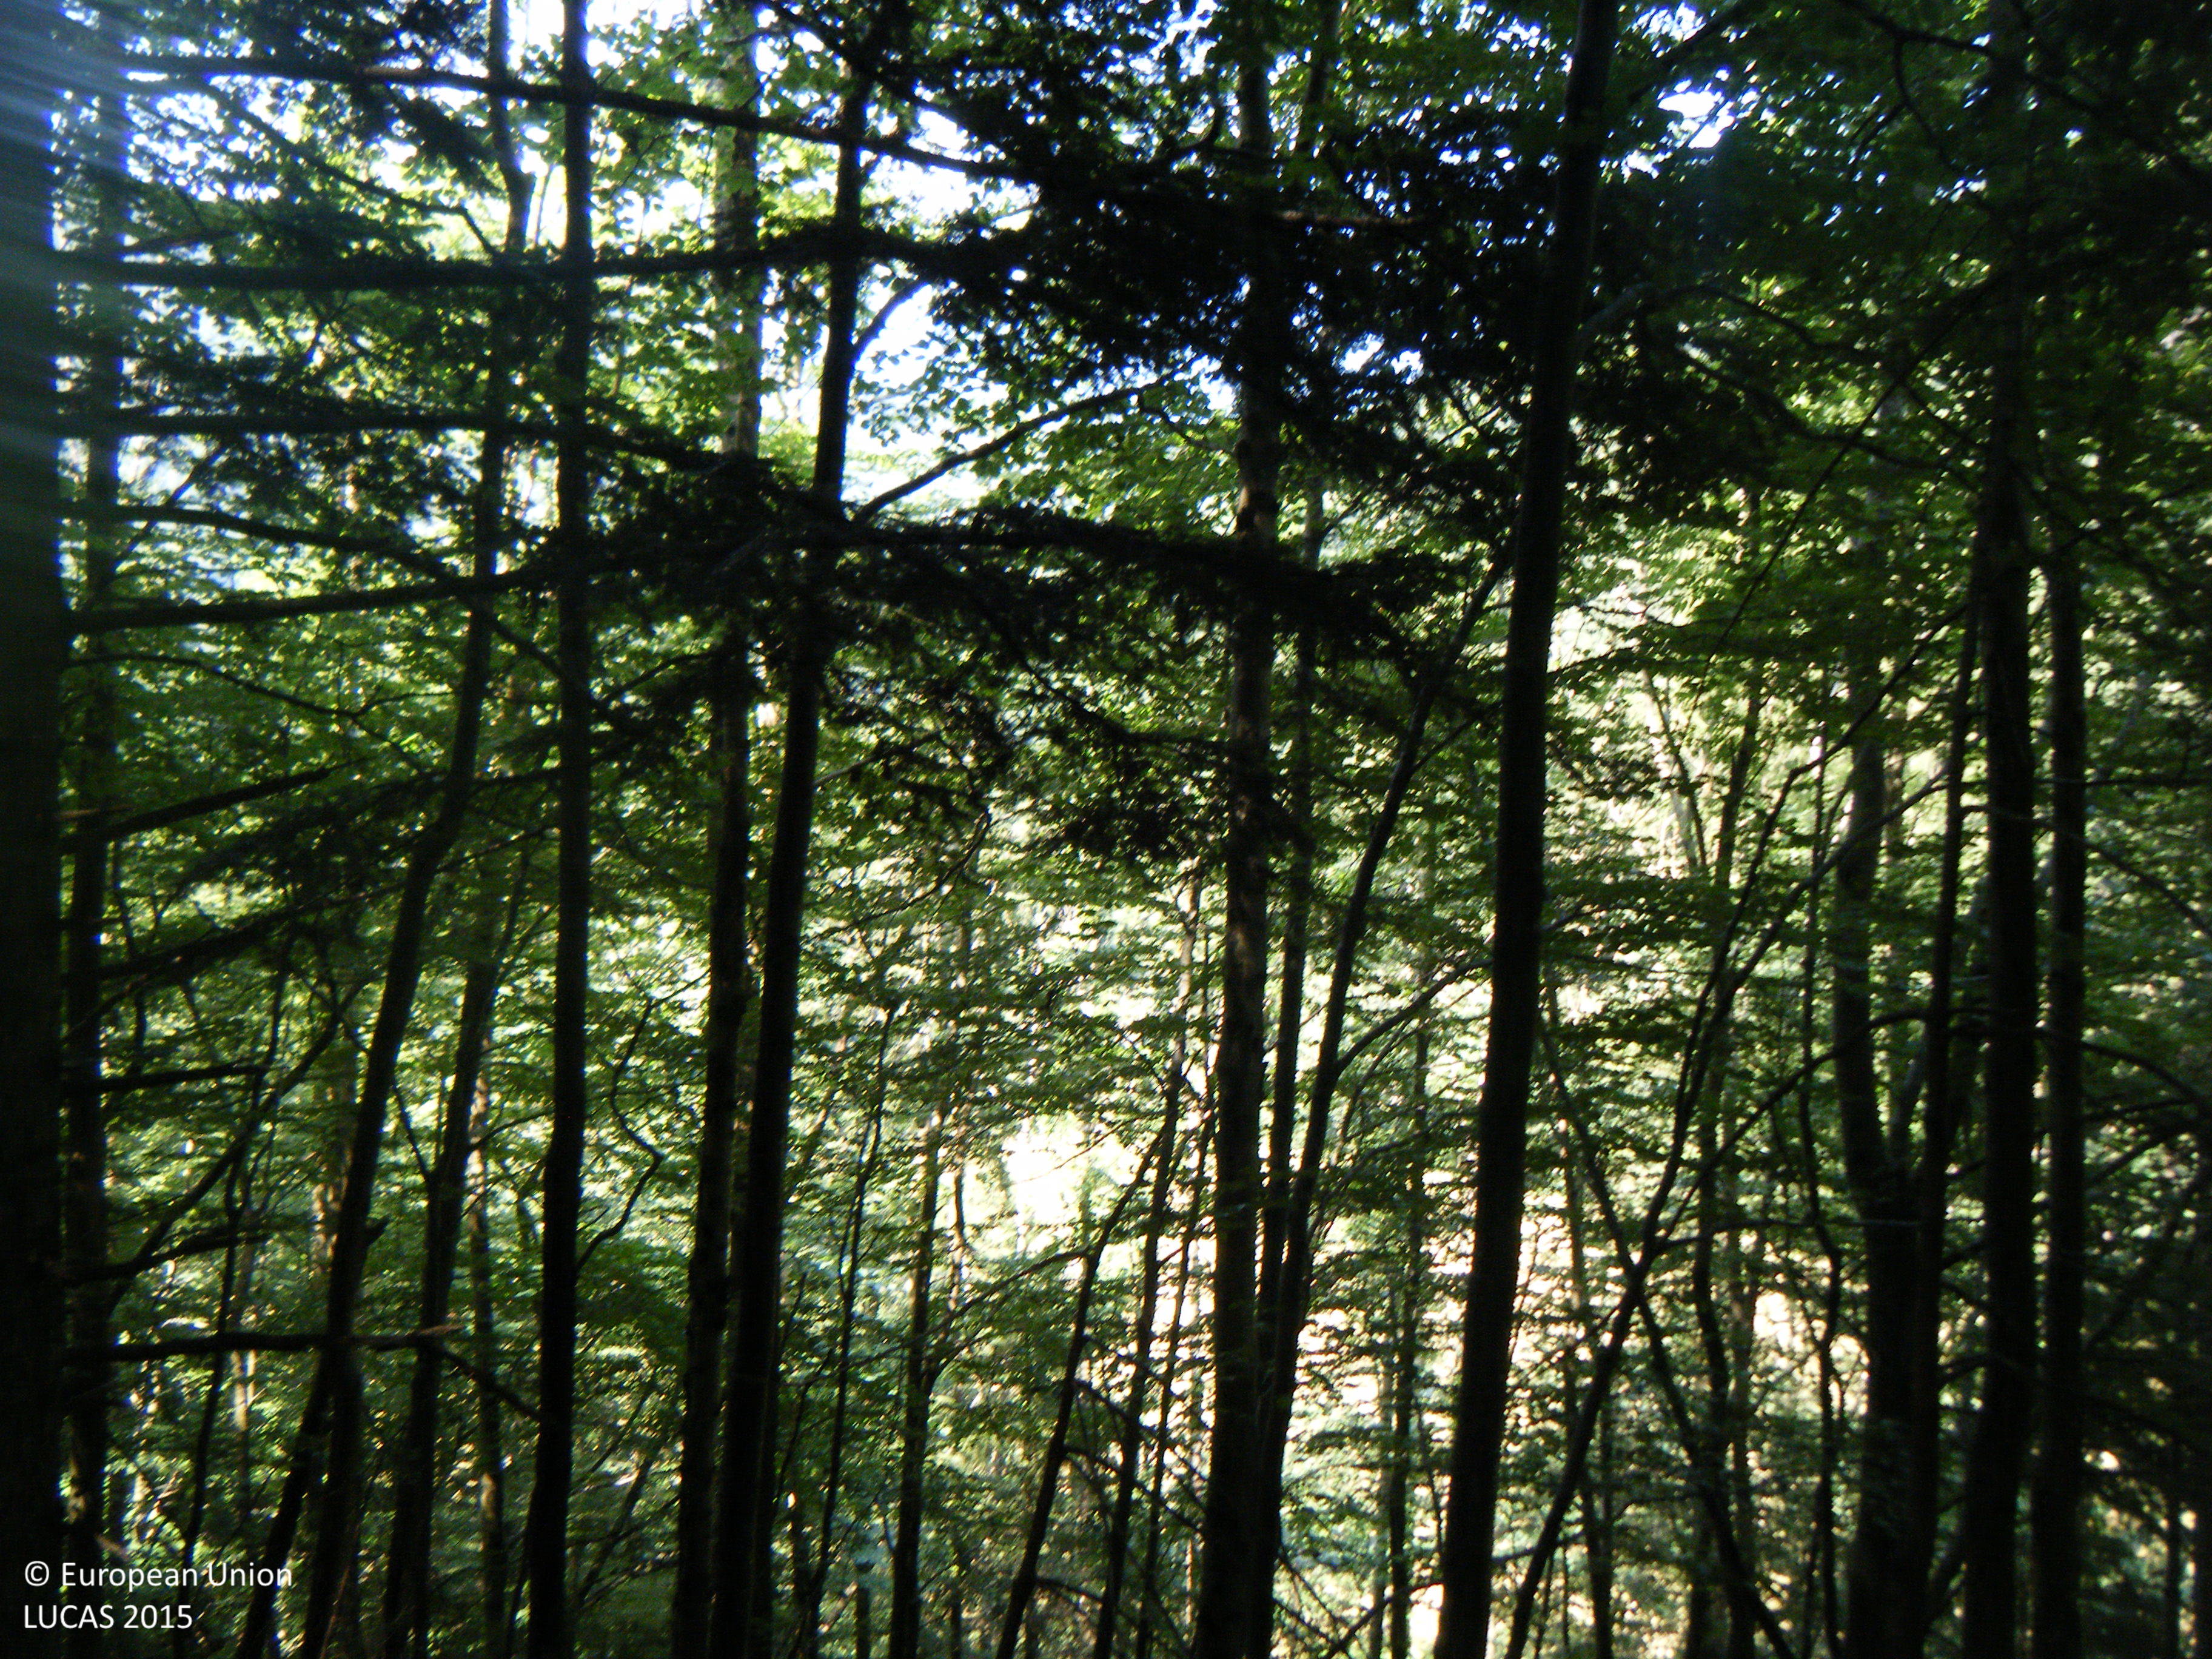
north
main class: Woodland
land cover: Spruce dominated mixed woodland
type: mountainous beech forest
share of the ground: > 75 %
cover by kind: broadleaved forest trees 65 %, coniferous forest trees 25 %, consolidated bare surface 10 %
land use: Forestry
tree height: > 5 m
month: July
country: AT
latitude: 47.7953
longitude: 13.3229
